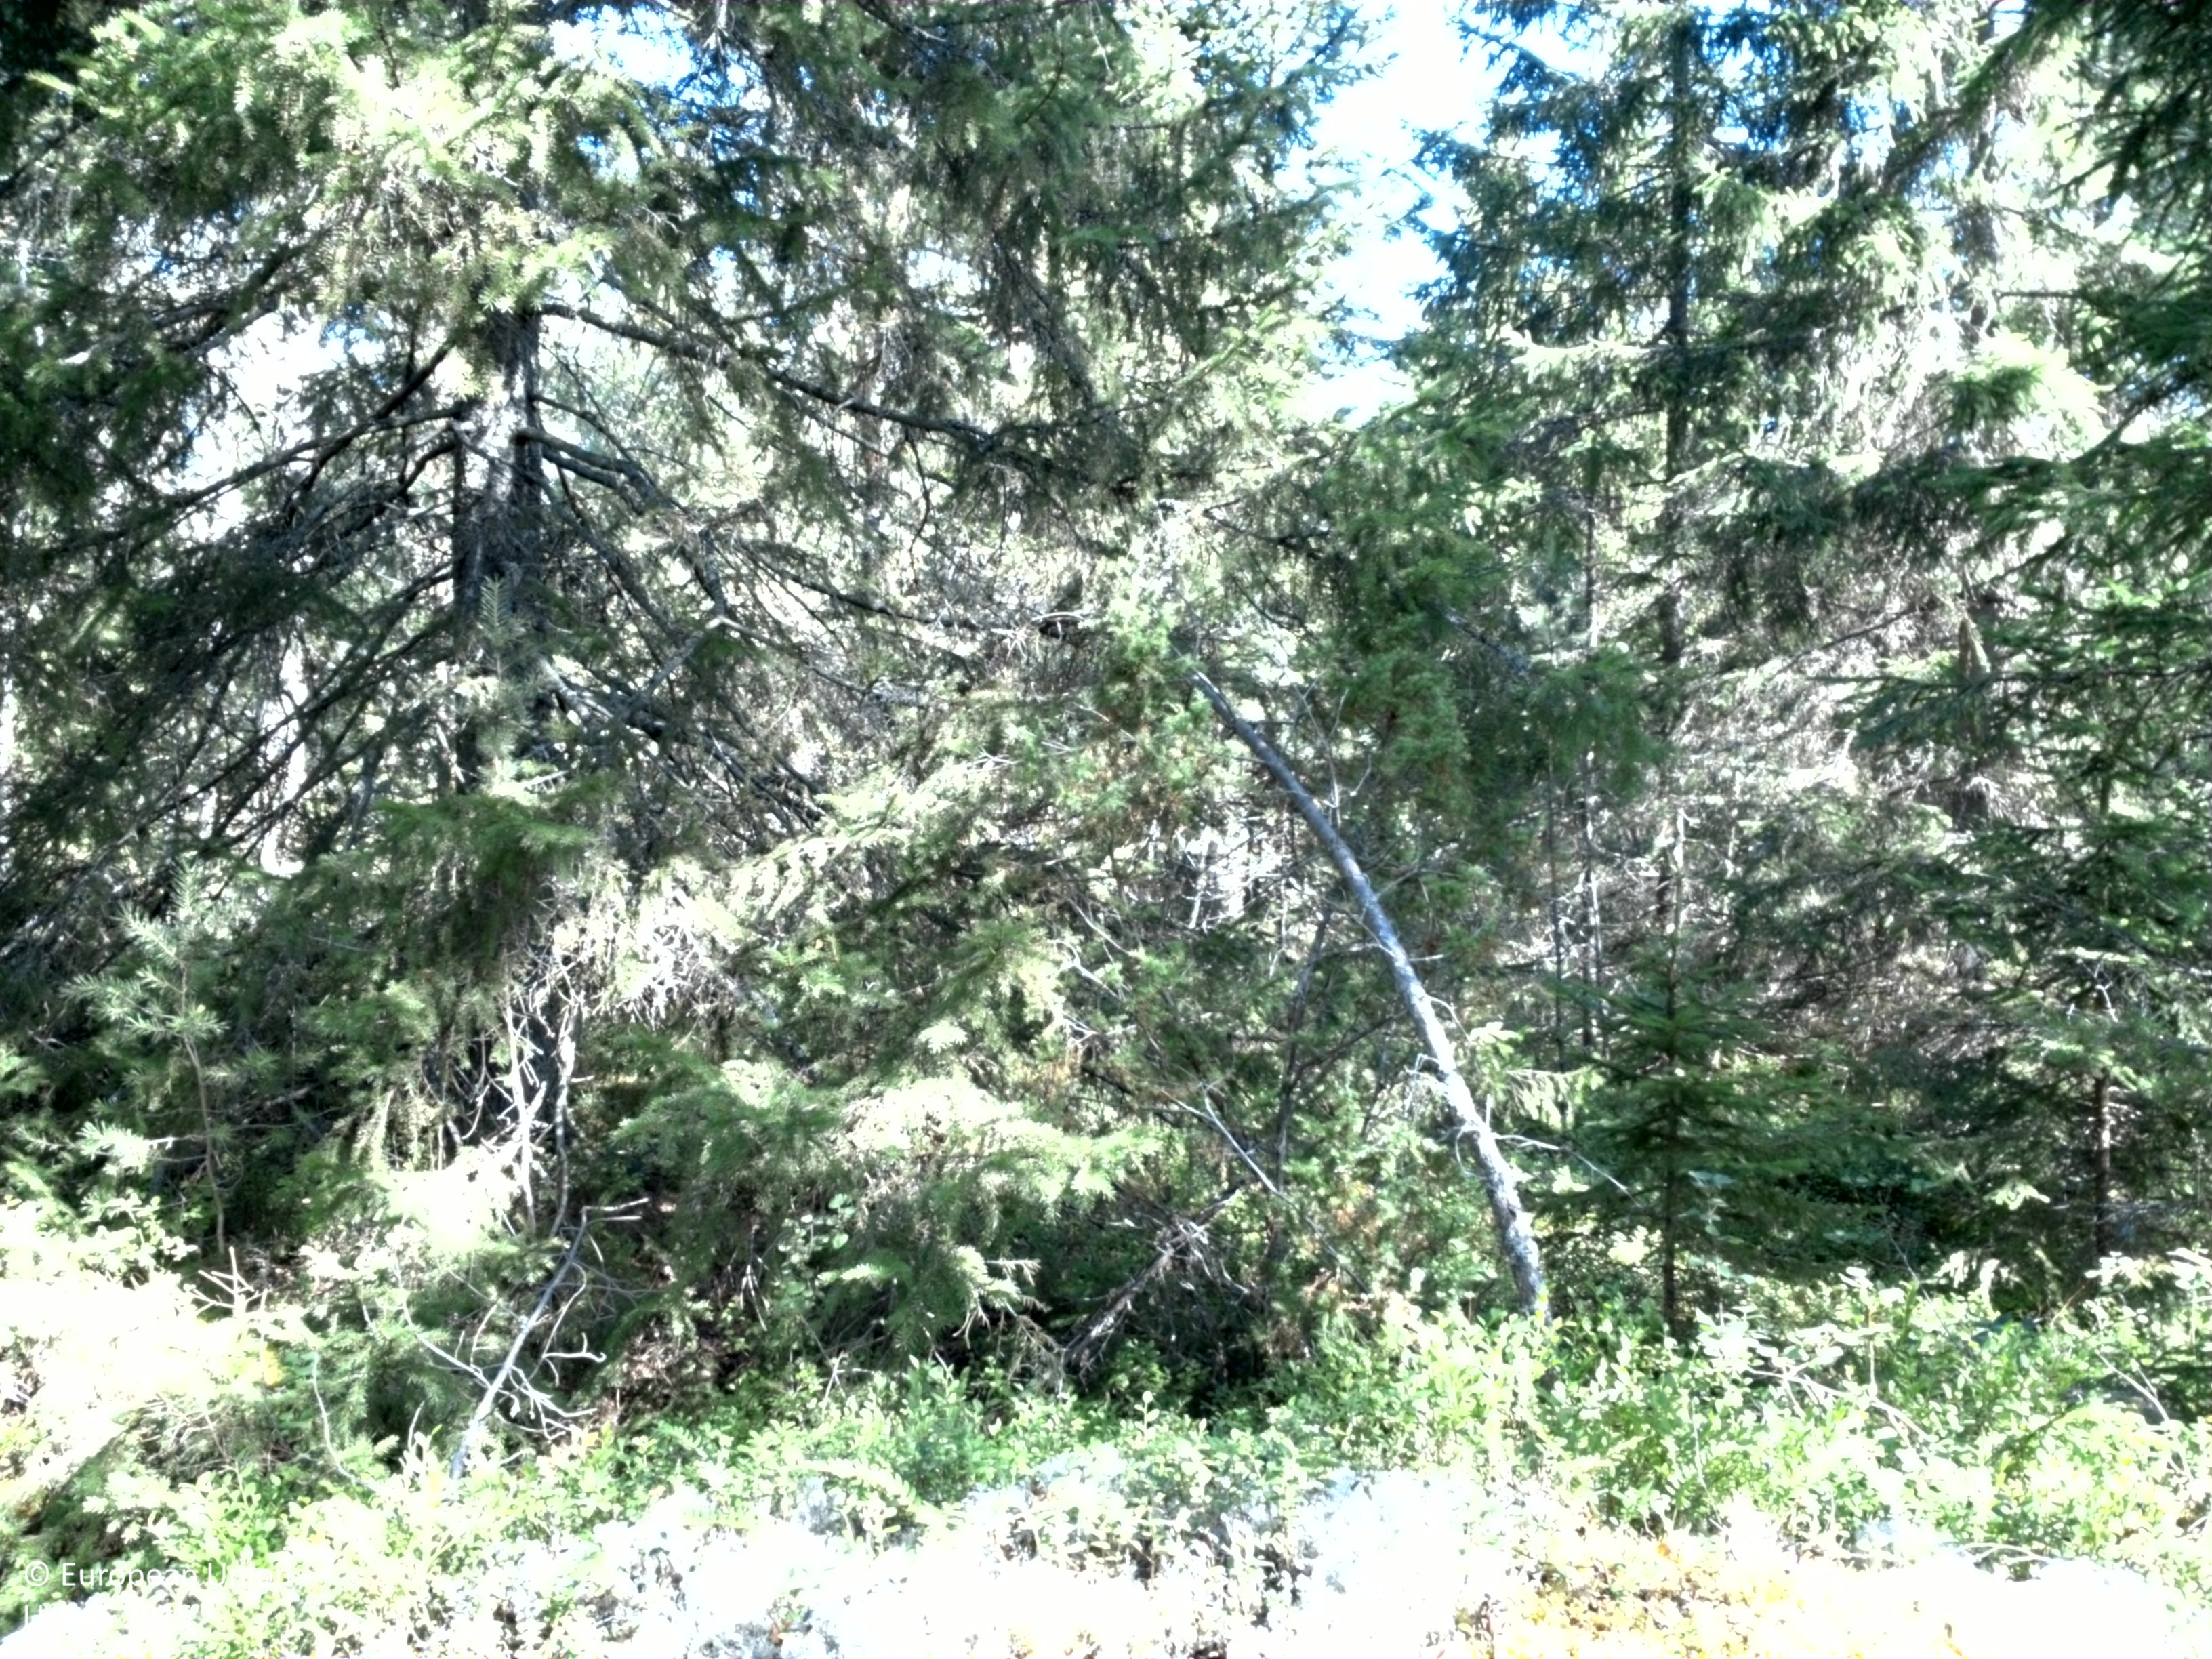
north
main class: Woodland
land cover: Spruce dominated coniferous woodland
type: boreal forest
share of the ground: > 75 %
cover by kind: coniferous forest trees 70 %, lichens and mosses 25 %, broadleaved forest trees 5 %
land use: Forestry
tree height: > 5 m
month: August
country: SE
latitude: 59.5452
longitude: 18.4723
